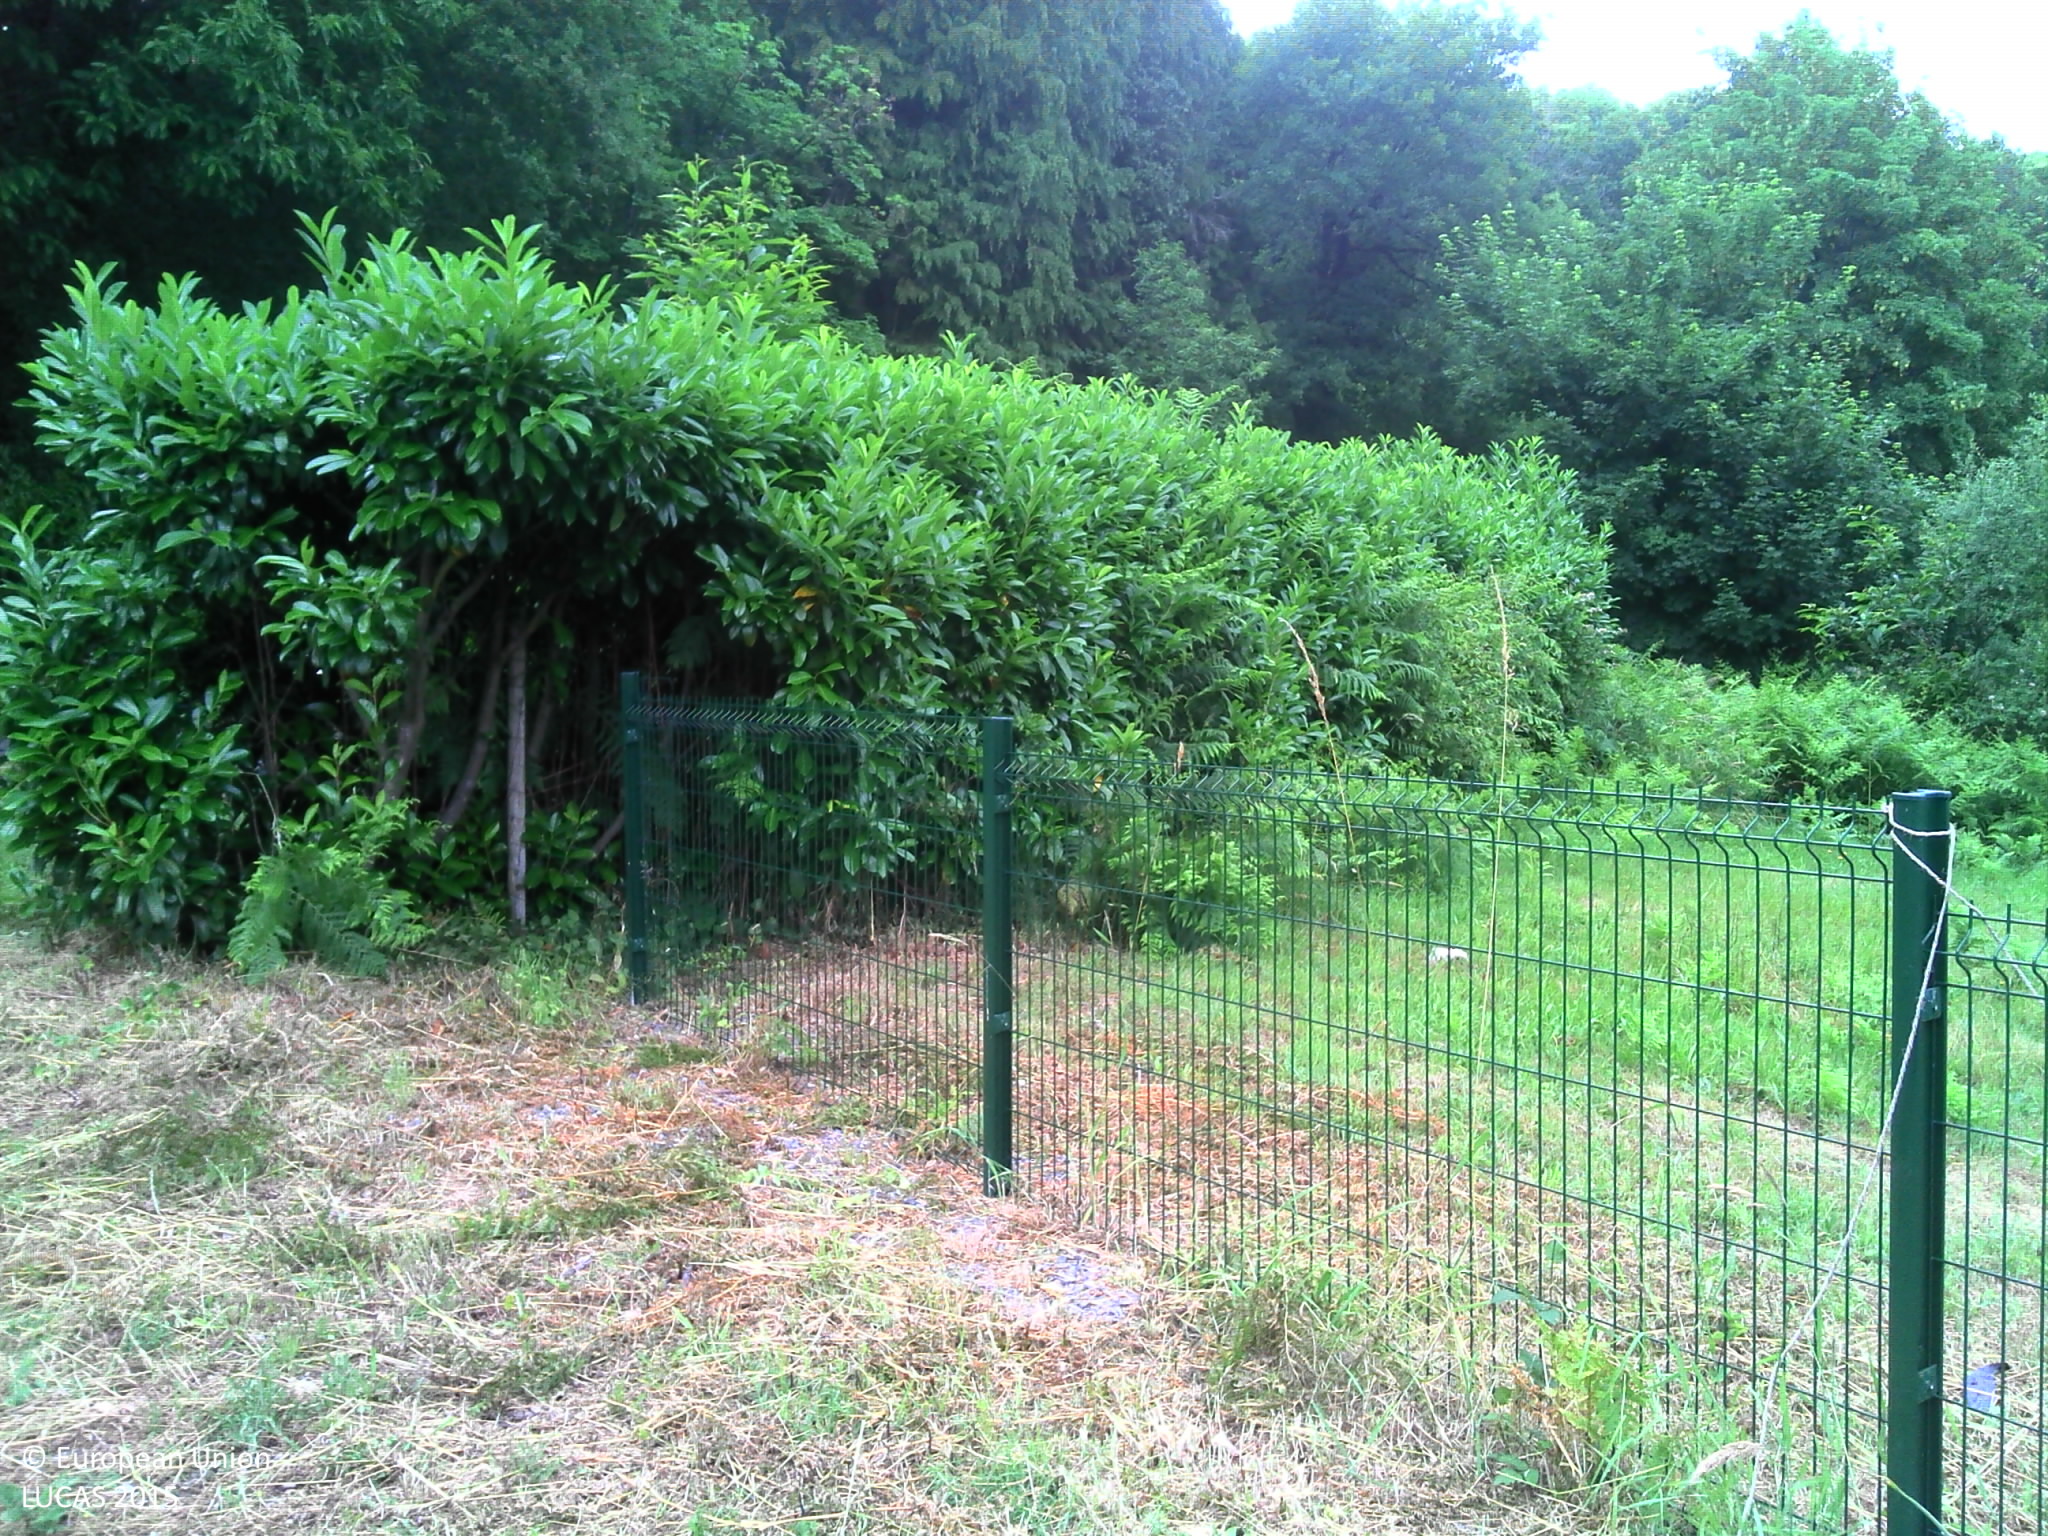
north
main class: Grassland
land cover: Grassland without tree/shrub cover
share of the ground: > 75 %
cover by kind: herbaceous plants 100 %
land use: Agriculture (excluding fallow land and kitchen gardens)
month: June
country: FR
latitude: 47.4606
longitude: 0.0120
